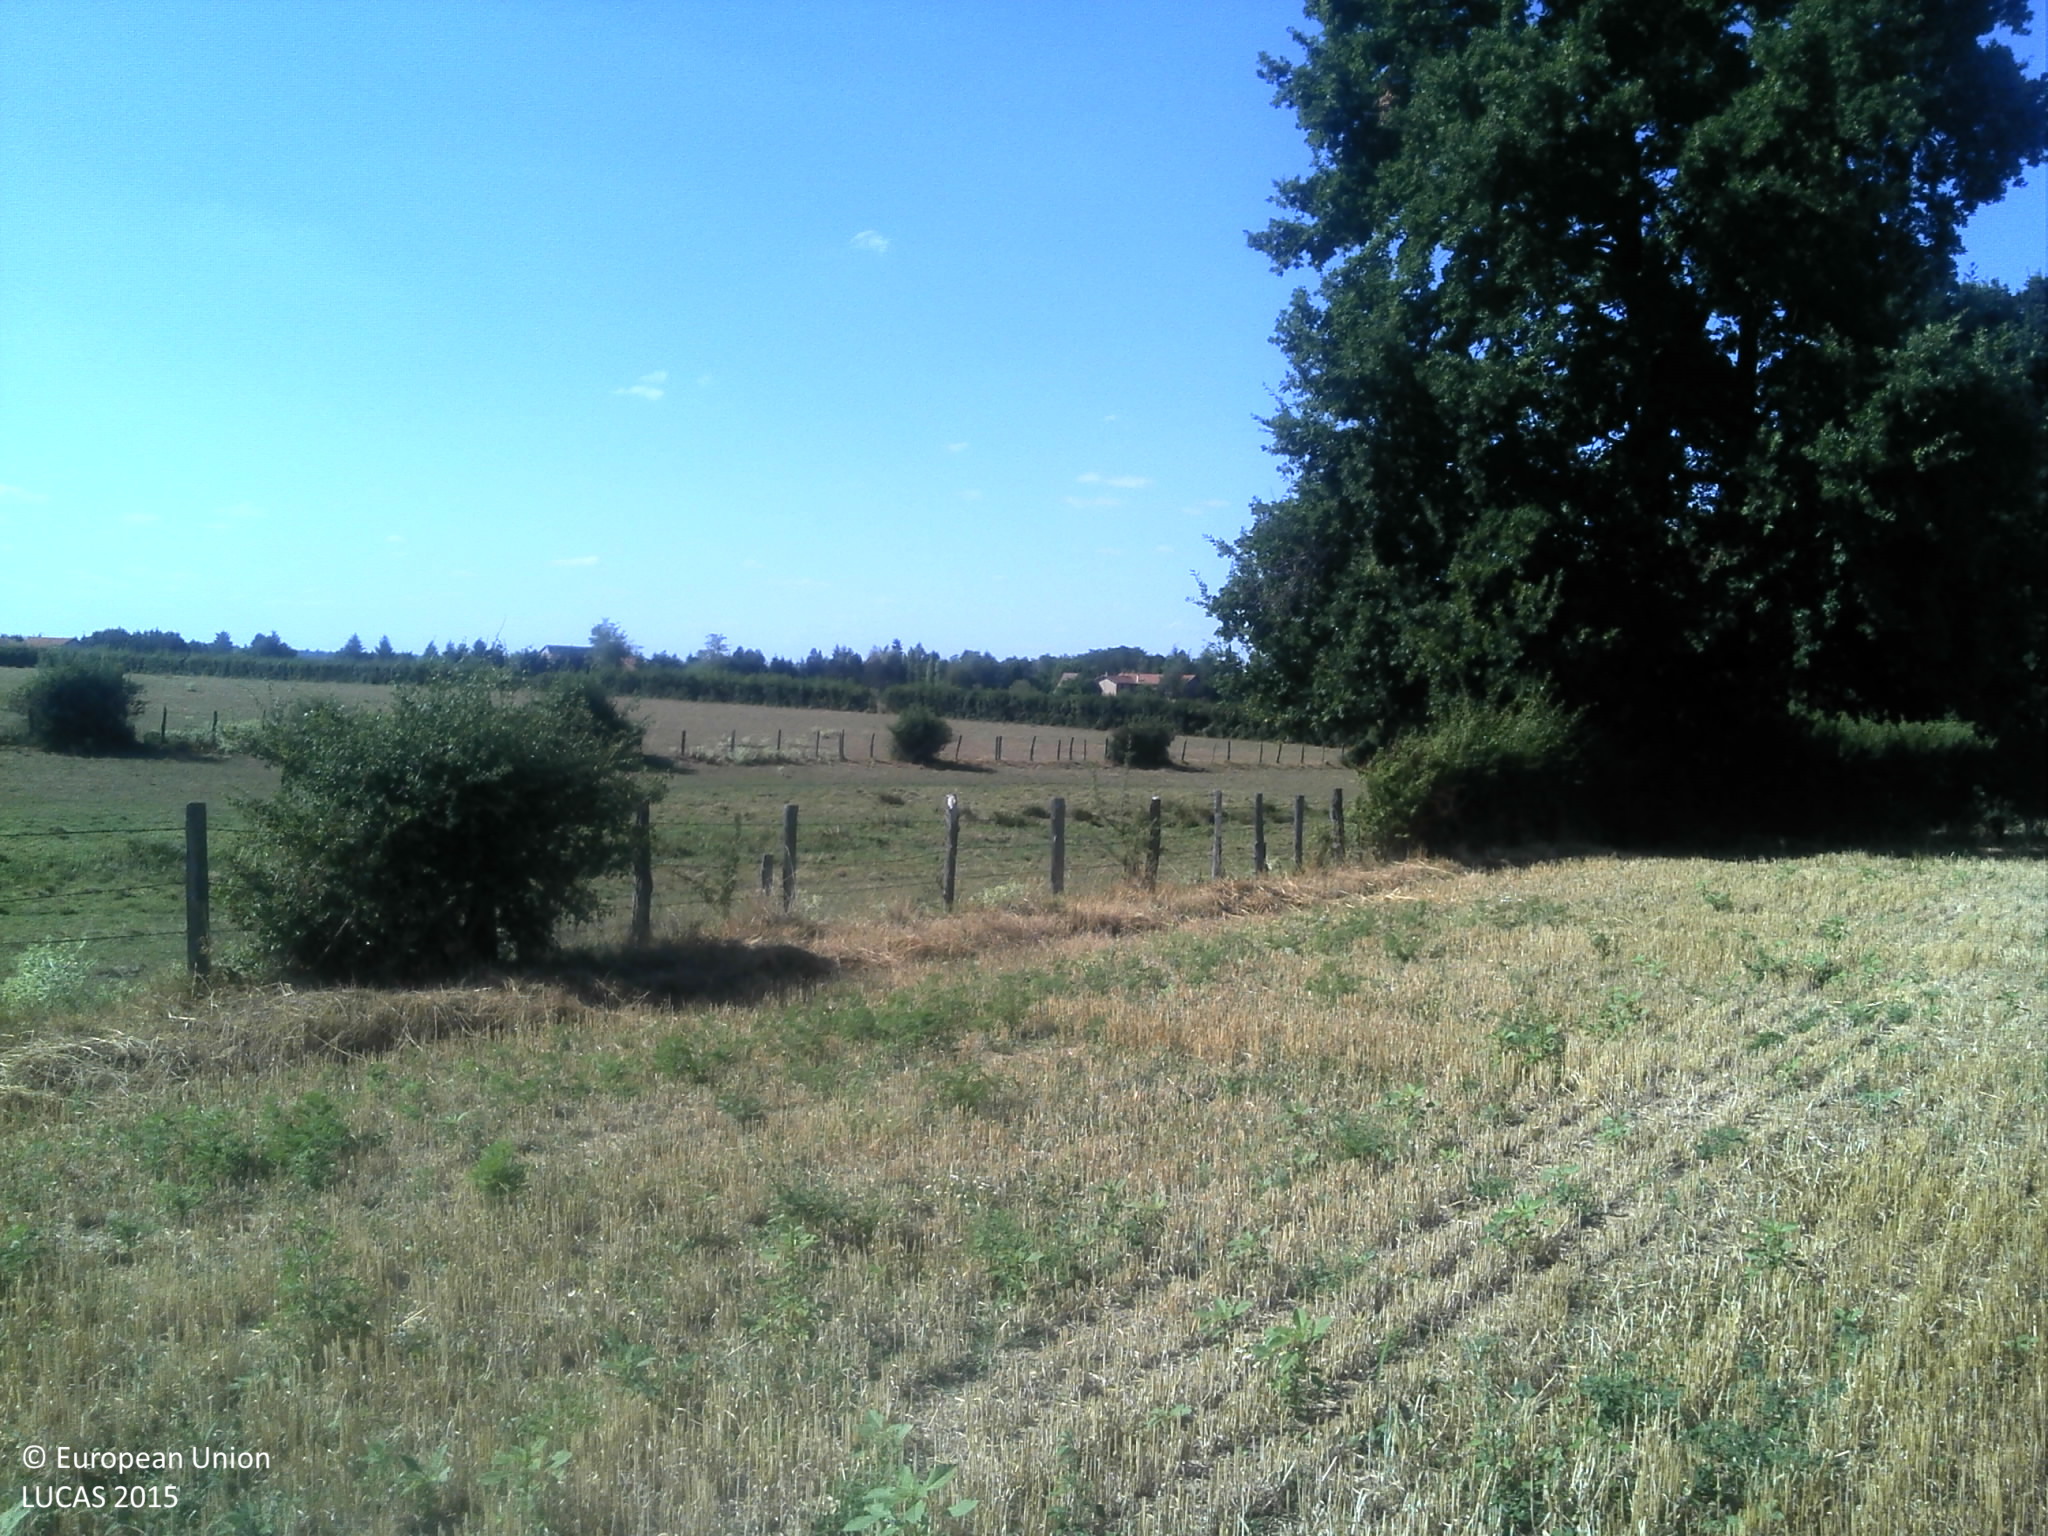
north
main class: Cropland
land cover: Barley
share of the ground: 50 - 75 %
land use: Agriculture (excluding fallow land and kitchen gardens)
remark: Harvested field
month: July
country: FR
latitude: 46.0063
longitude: 4.0742
